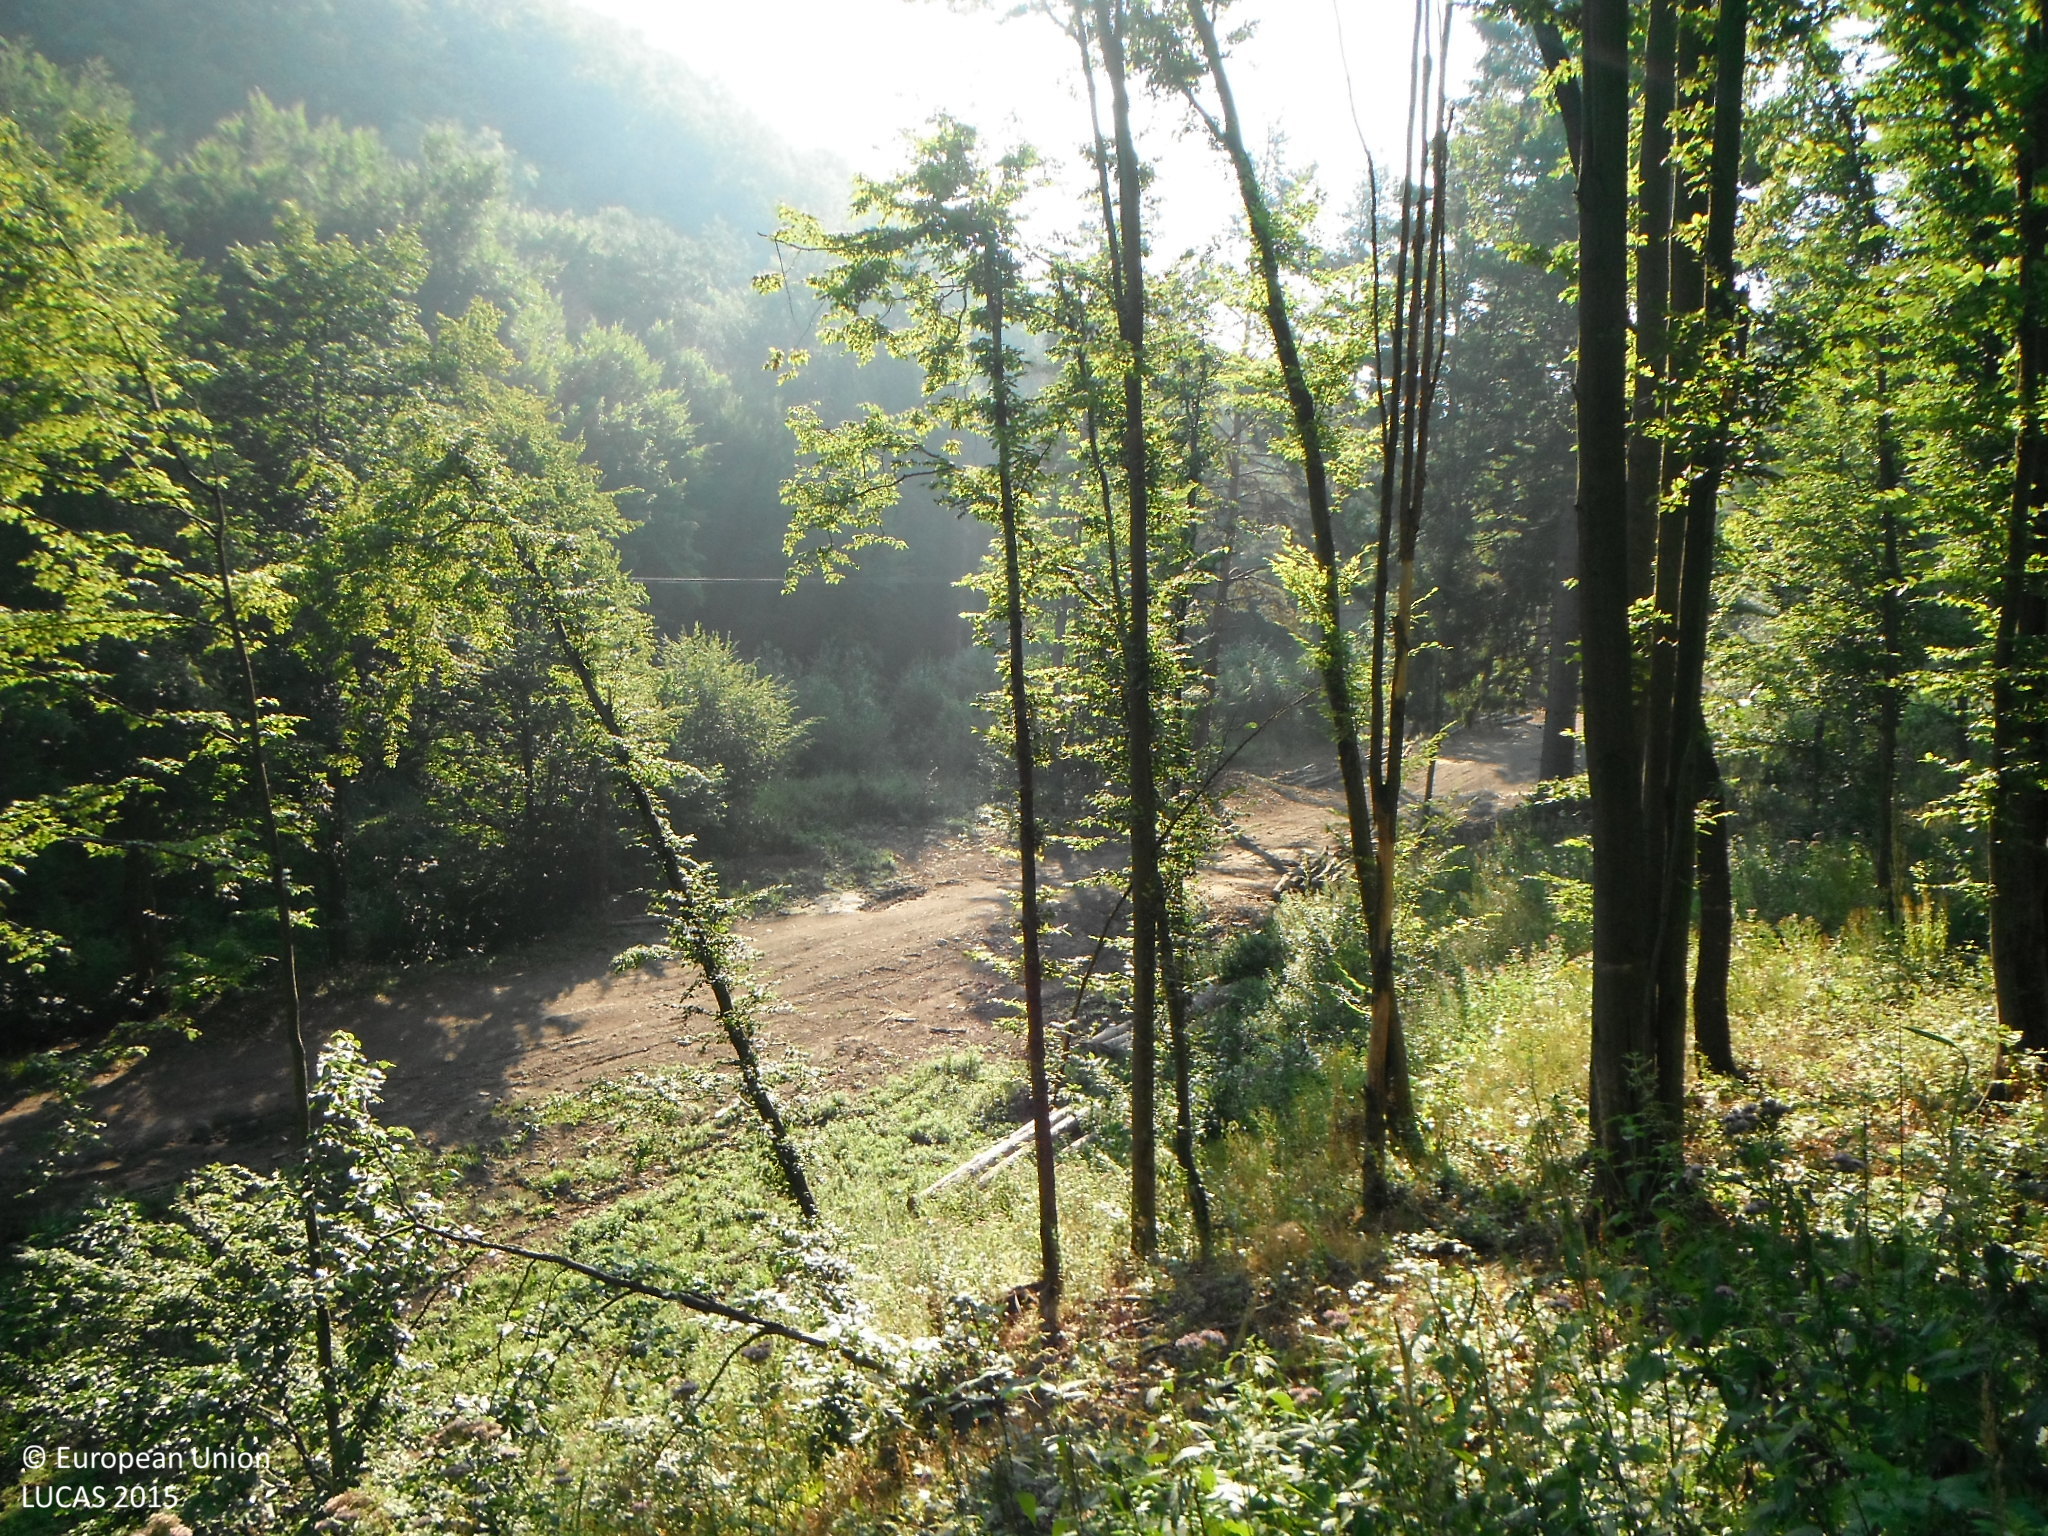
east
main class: Woodland
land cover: Broadleaved woodland
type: mountainous beech forest
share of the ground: 50 - 75 %
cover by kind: broadleaved forest trees 90 %, coniferous forest trees 5 %, herbaceous plants 5 %
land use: Forestry
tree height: > 5 m
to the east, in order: Broadleaved woodland; Spontaneously vegetated surfaces; Tracks; Pine dominated mixed woodland; Shrubland without tree cover; Electric lines; Shrubland without tree cover; Broadleaved woodland; Rivers and streams; Broadleaved woodland; Tracks; Broadleaved woodland; Tracks; Broadleaved woodland
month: August
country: SK
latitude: 48.3978
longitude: 19.2201
